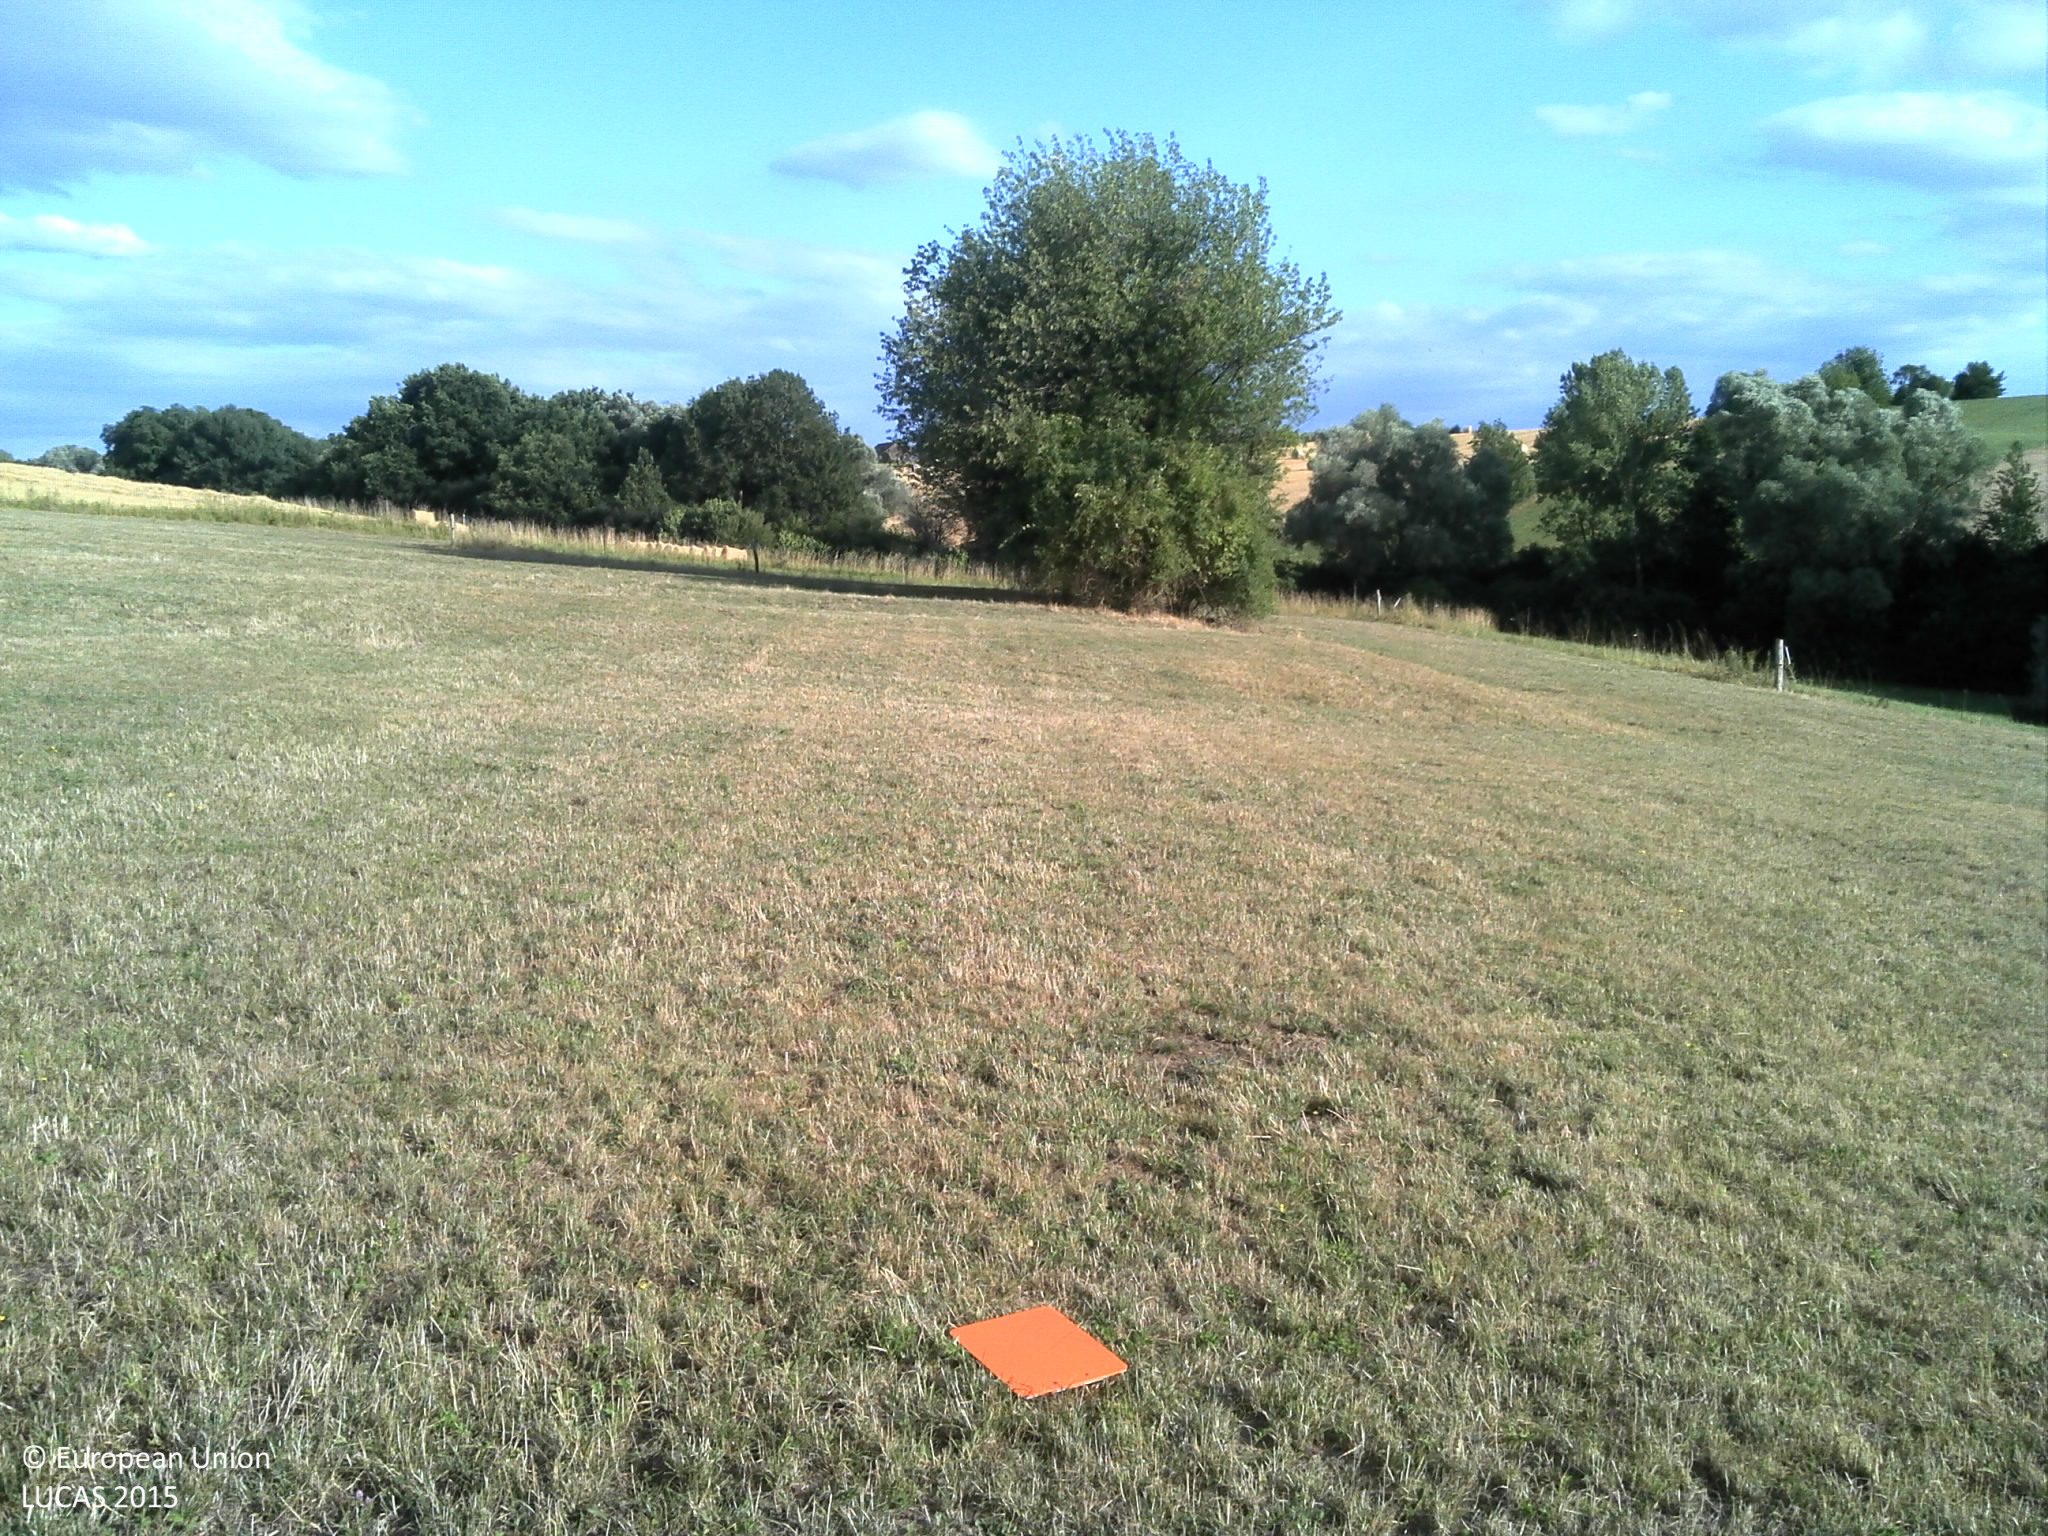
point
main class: Grassland
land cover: Grassland without tree/shrub cover
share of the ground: > 75 %
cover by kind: herbaceous plants 100 %
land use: Agriculture (excluding fallow land and kitchen gardens)
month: July
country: FR
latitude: 49.1099
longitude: 7.3566
